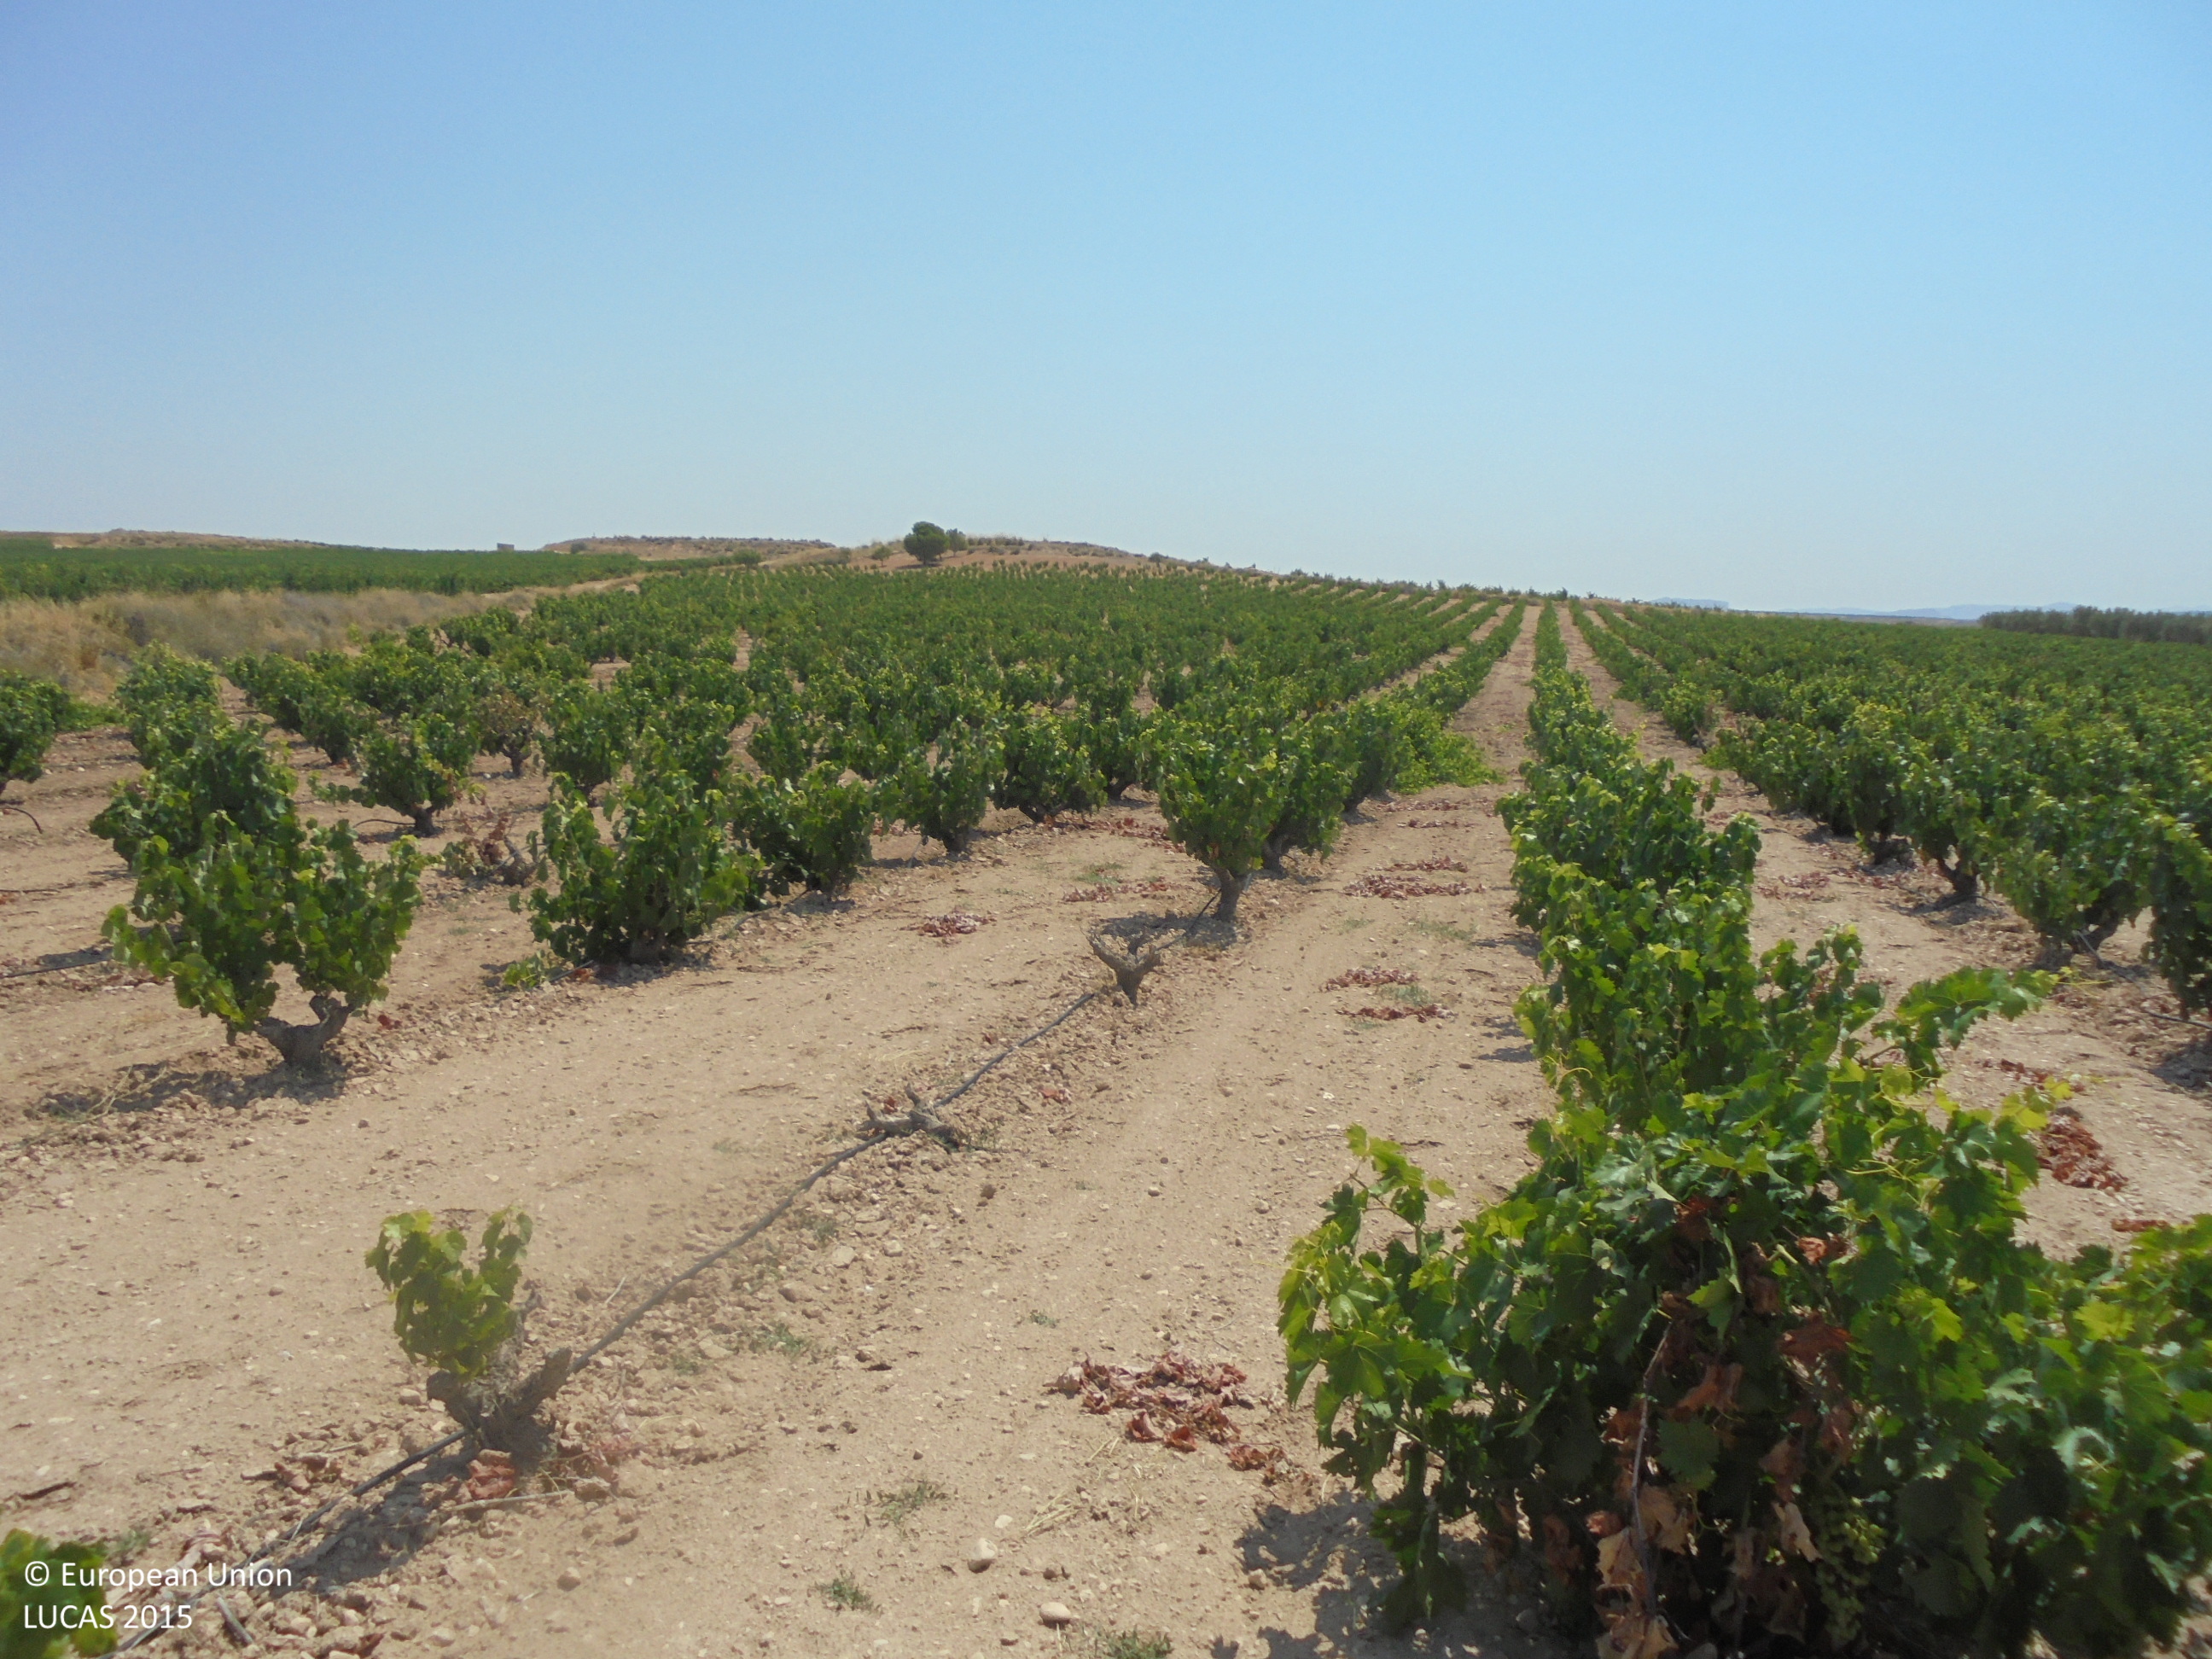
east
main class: Cropland
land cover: Vineyards
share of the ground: 10 - 25 %
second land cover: Other bare soil
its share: > 75 %
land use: Agriculture (excluding fallow land and kitchen gardens)
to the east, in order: Vineyards; Other bare soil; Grass margins; Dry stone walls; Grass margins; Vineyards
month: July
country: ES
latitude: 38.5858
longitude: -1.4845
